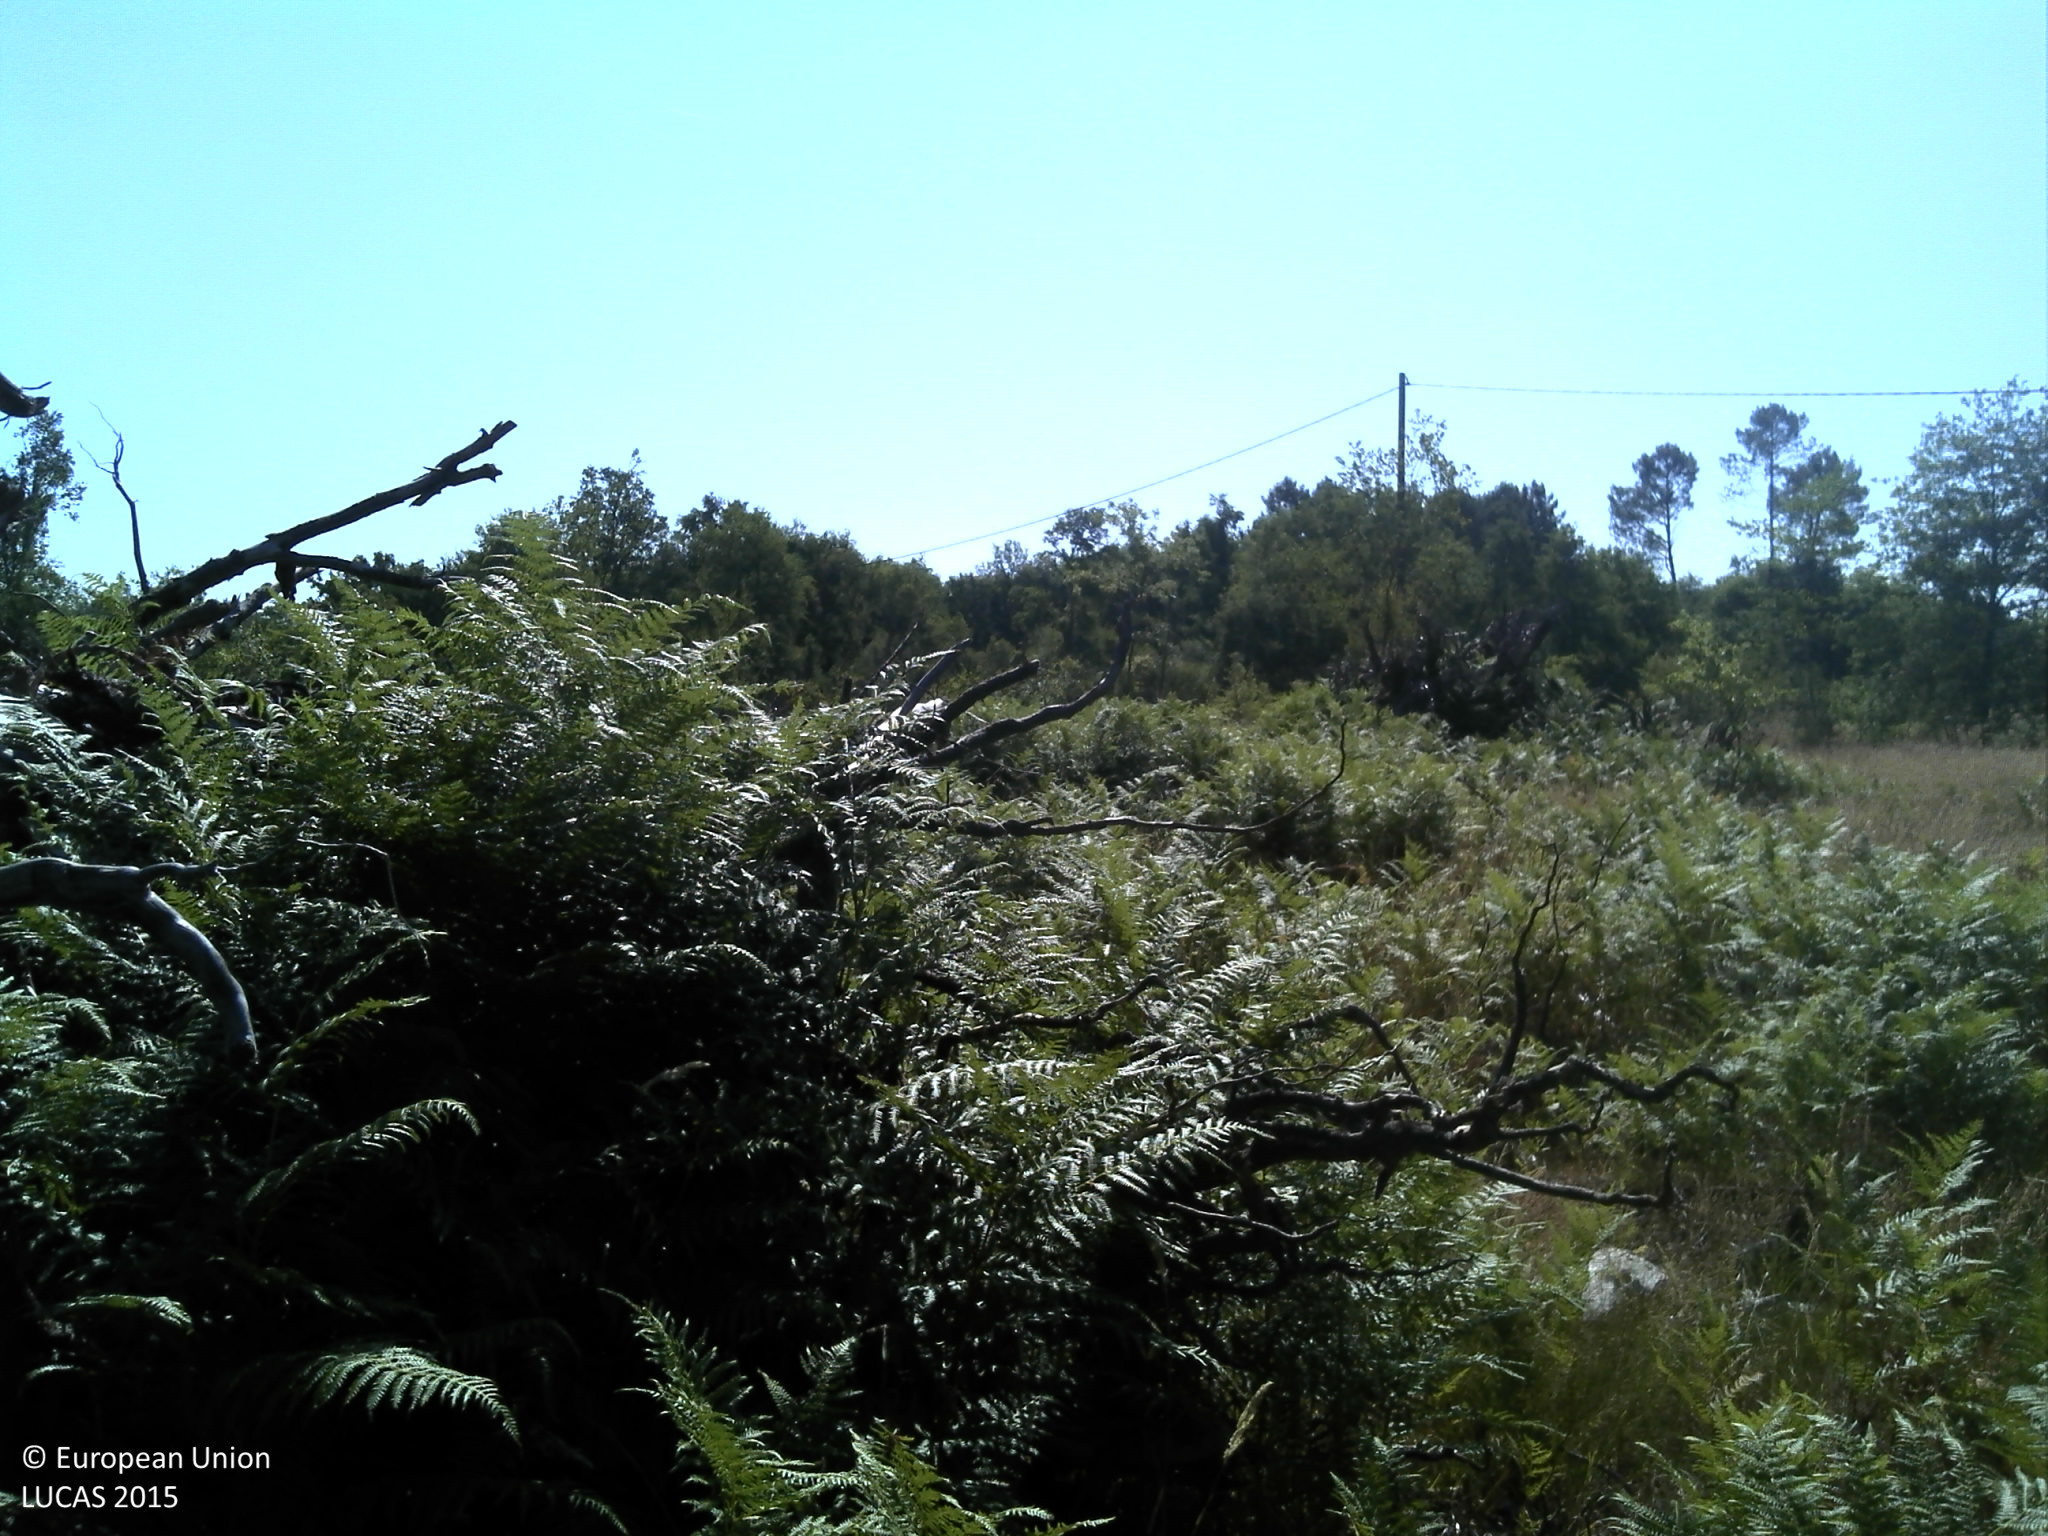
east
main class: Grassland
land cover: Spontaneously vegetated surfaces
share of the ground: > 75 %
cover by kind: herbaceous plants 90 %, shrubs 5 %, lichens and mosses 5 %
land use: Semi-natural and natural areas not in use
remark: Clear cut
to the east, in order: Spontaneously vegetated surfaces; Electric lines; Pine dominated mixed woodland; Ditches and canals; Pine dominated mixed woodland; Electric lines; Pine dominated mixed woodland; Tracks; Ditches and canals; Fences; Shrubland with sparse tree cover; Grassland without tree/shrub cover; Broadleaved woodland
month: July
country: FR
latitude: 44.3878
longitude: -0.4208
